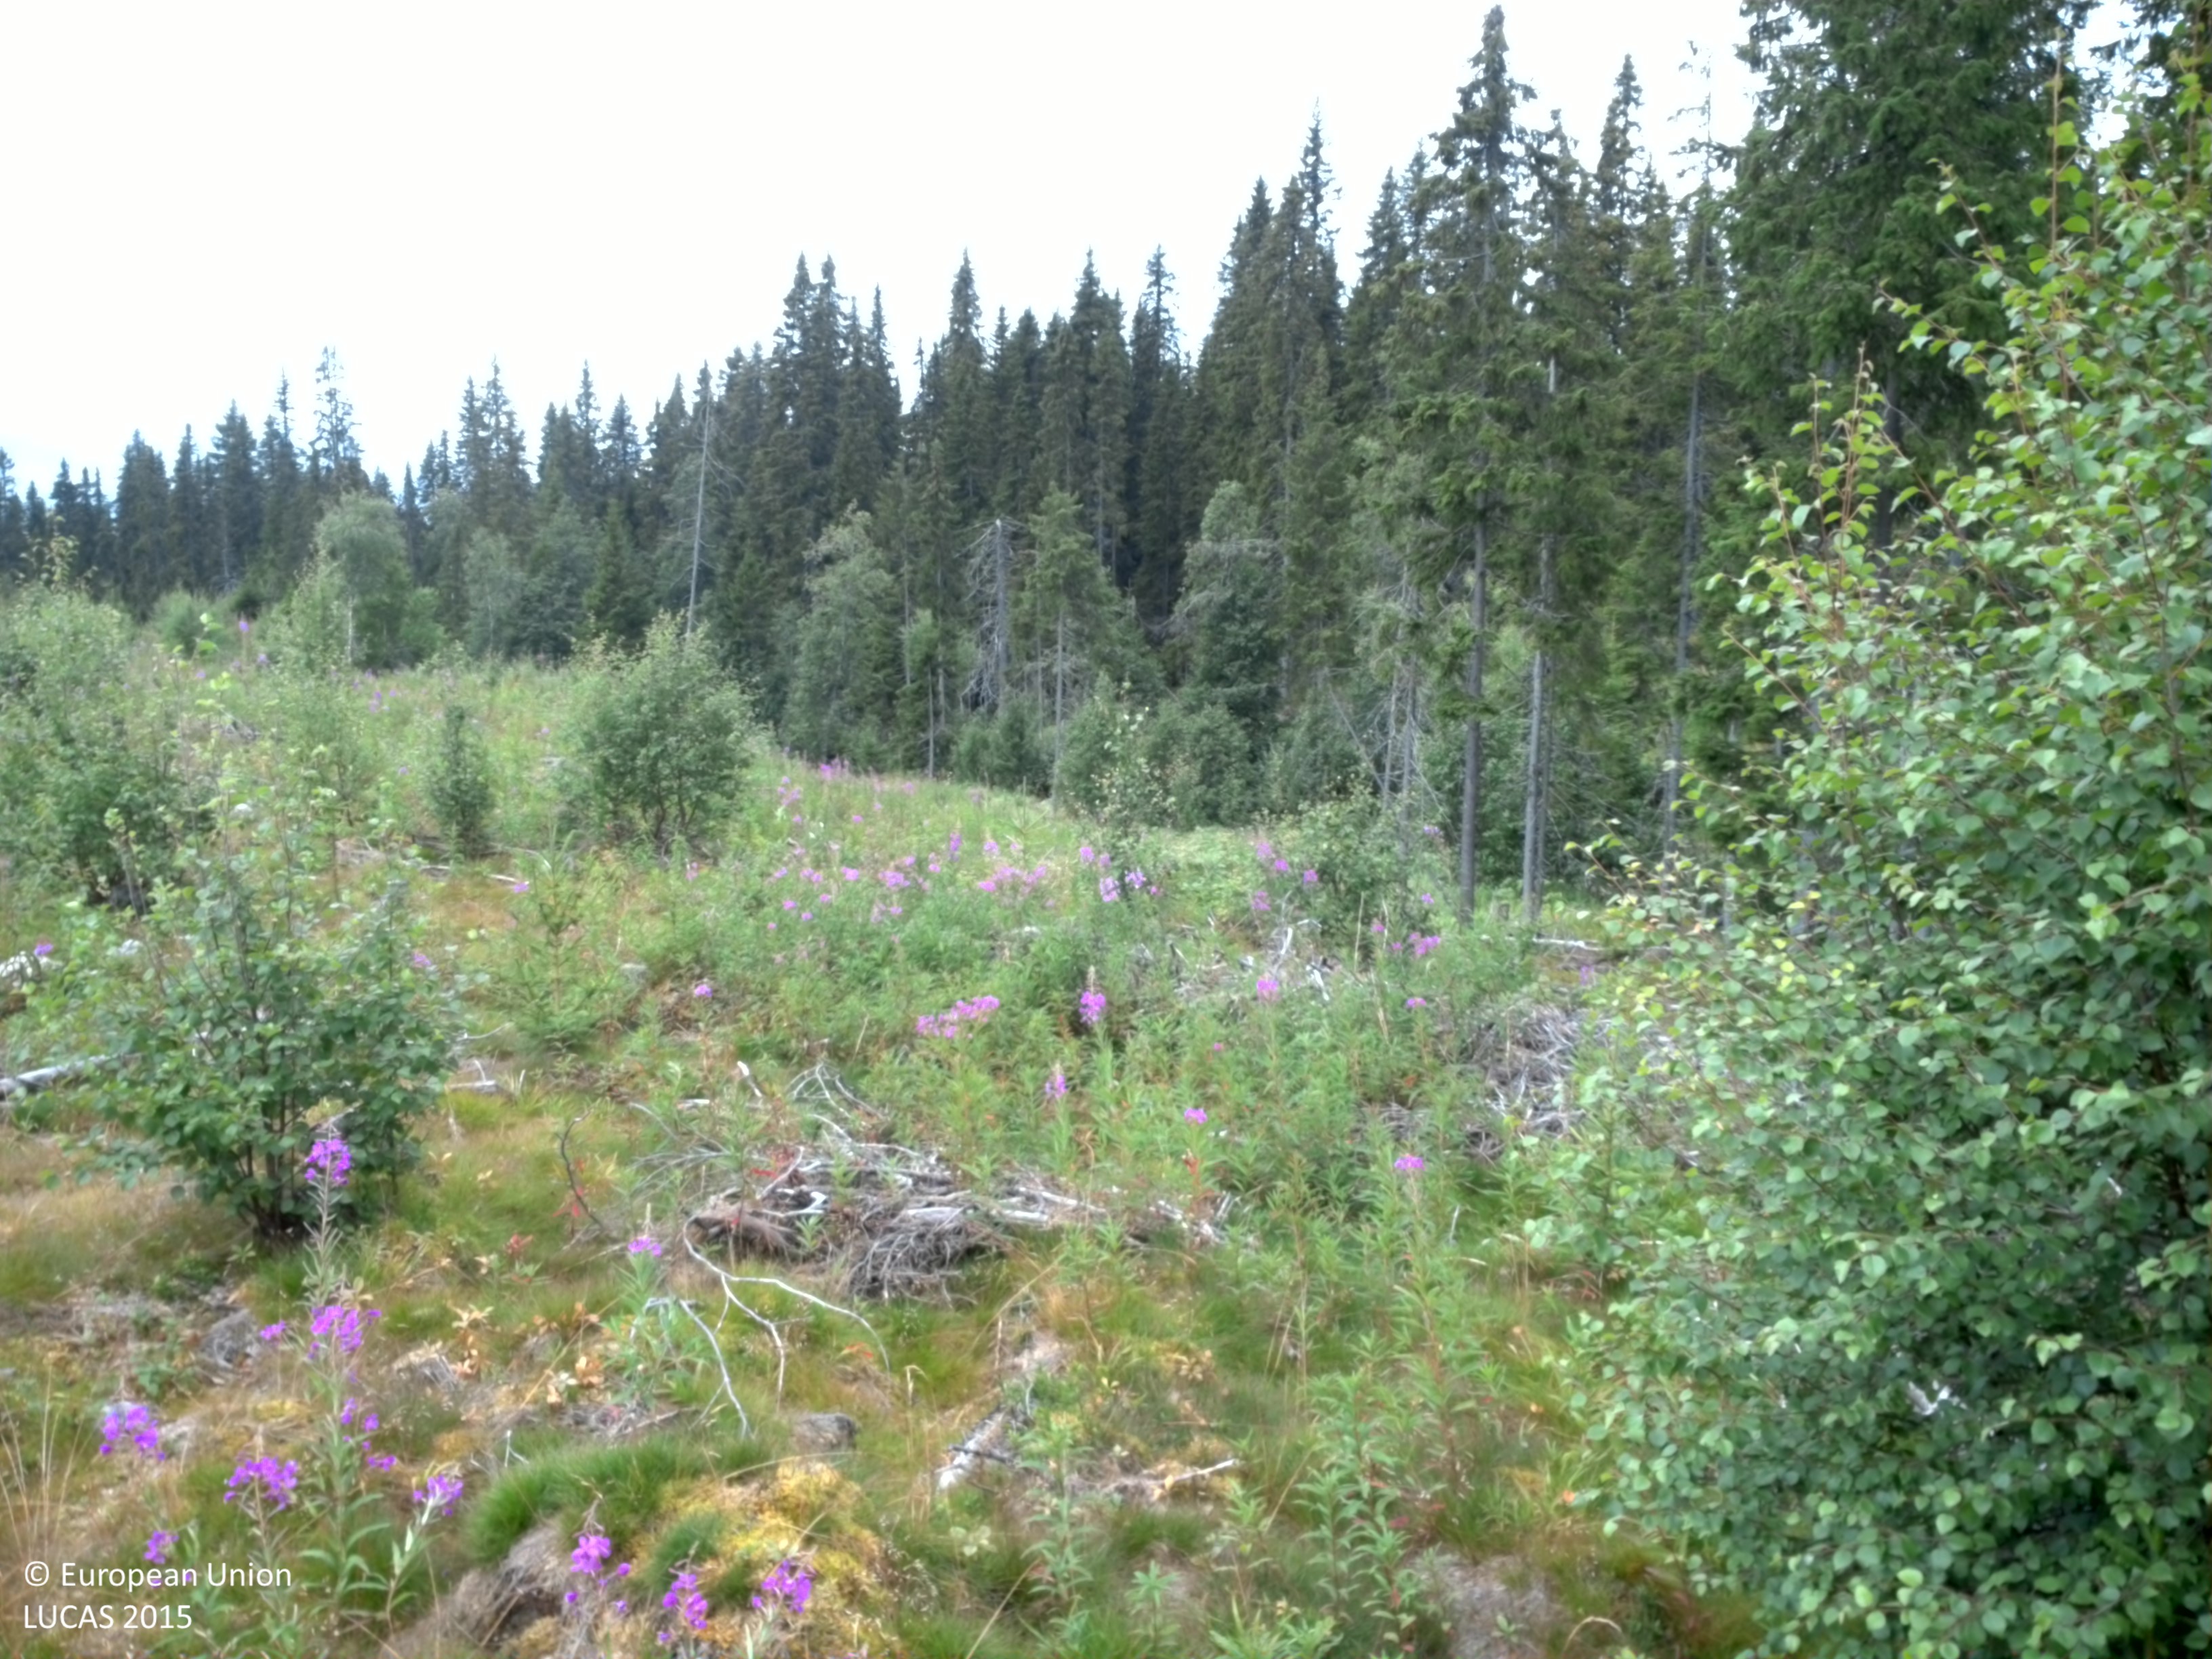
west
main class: Grassland
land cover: Grassland with sparse tree/shrub cover
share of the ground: > 75 %
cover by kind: herbaceous plants 80 %, broadleaved forest trees 5 %, shrubs 5 %, lichens and mosses 5 %
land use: Forestry
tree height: < 5 m
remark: Clear cut
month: August
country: SE
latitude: 64.7869
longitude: 16.5933
